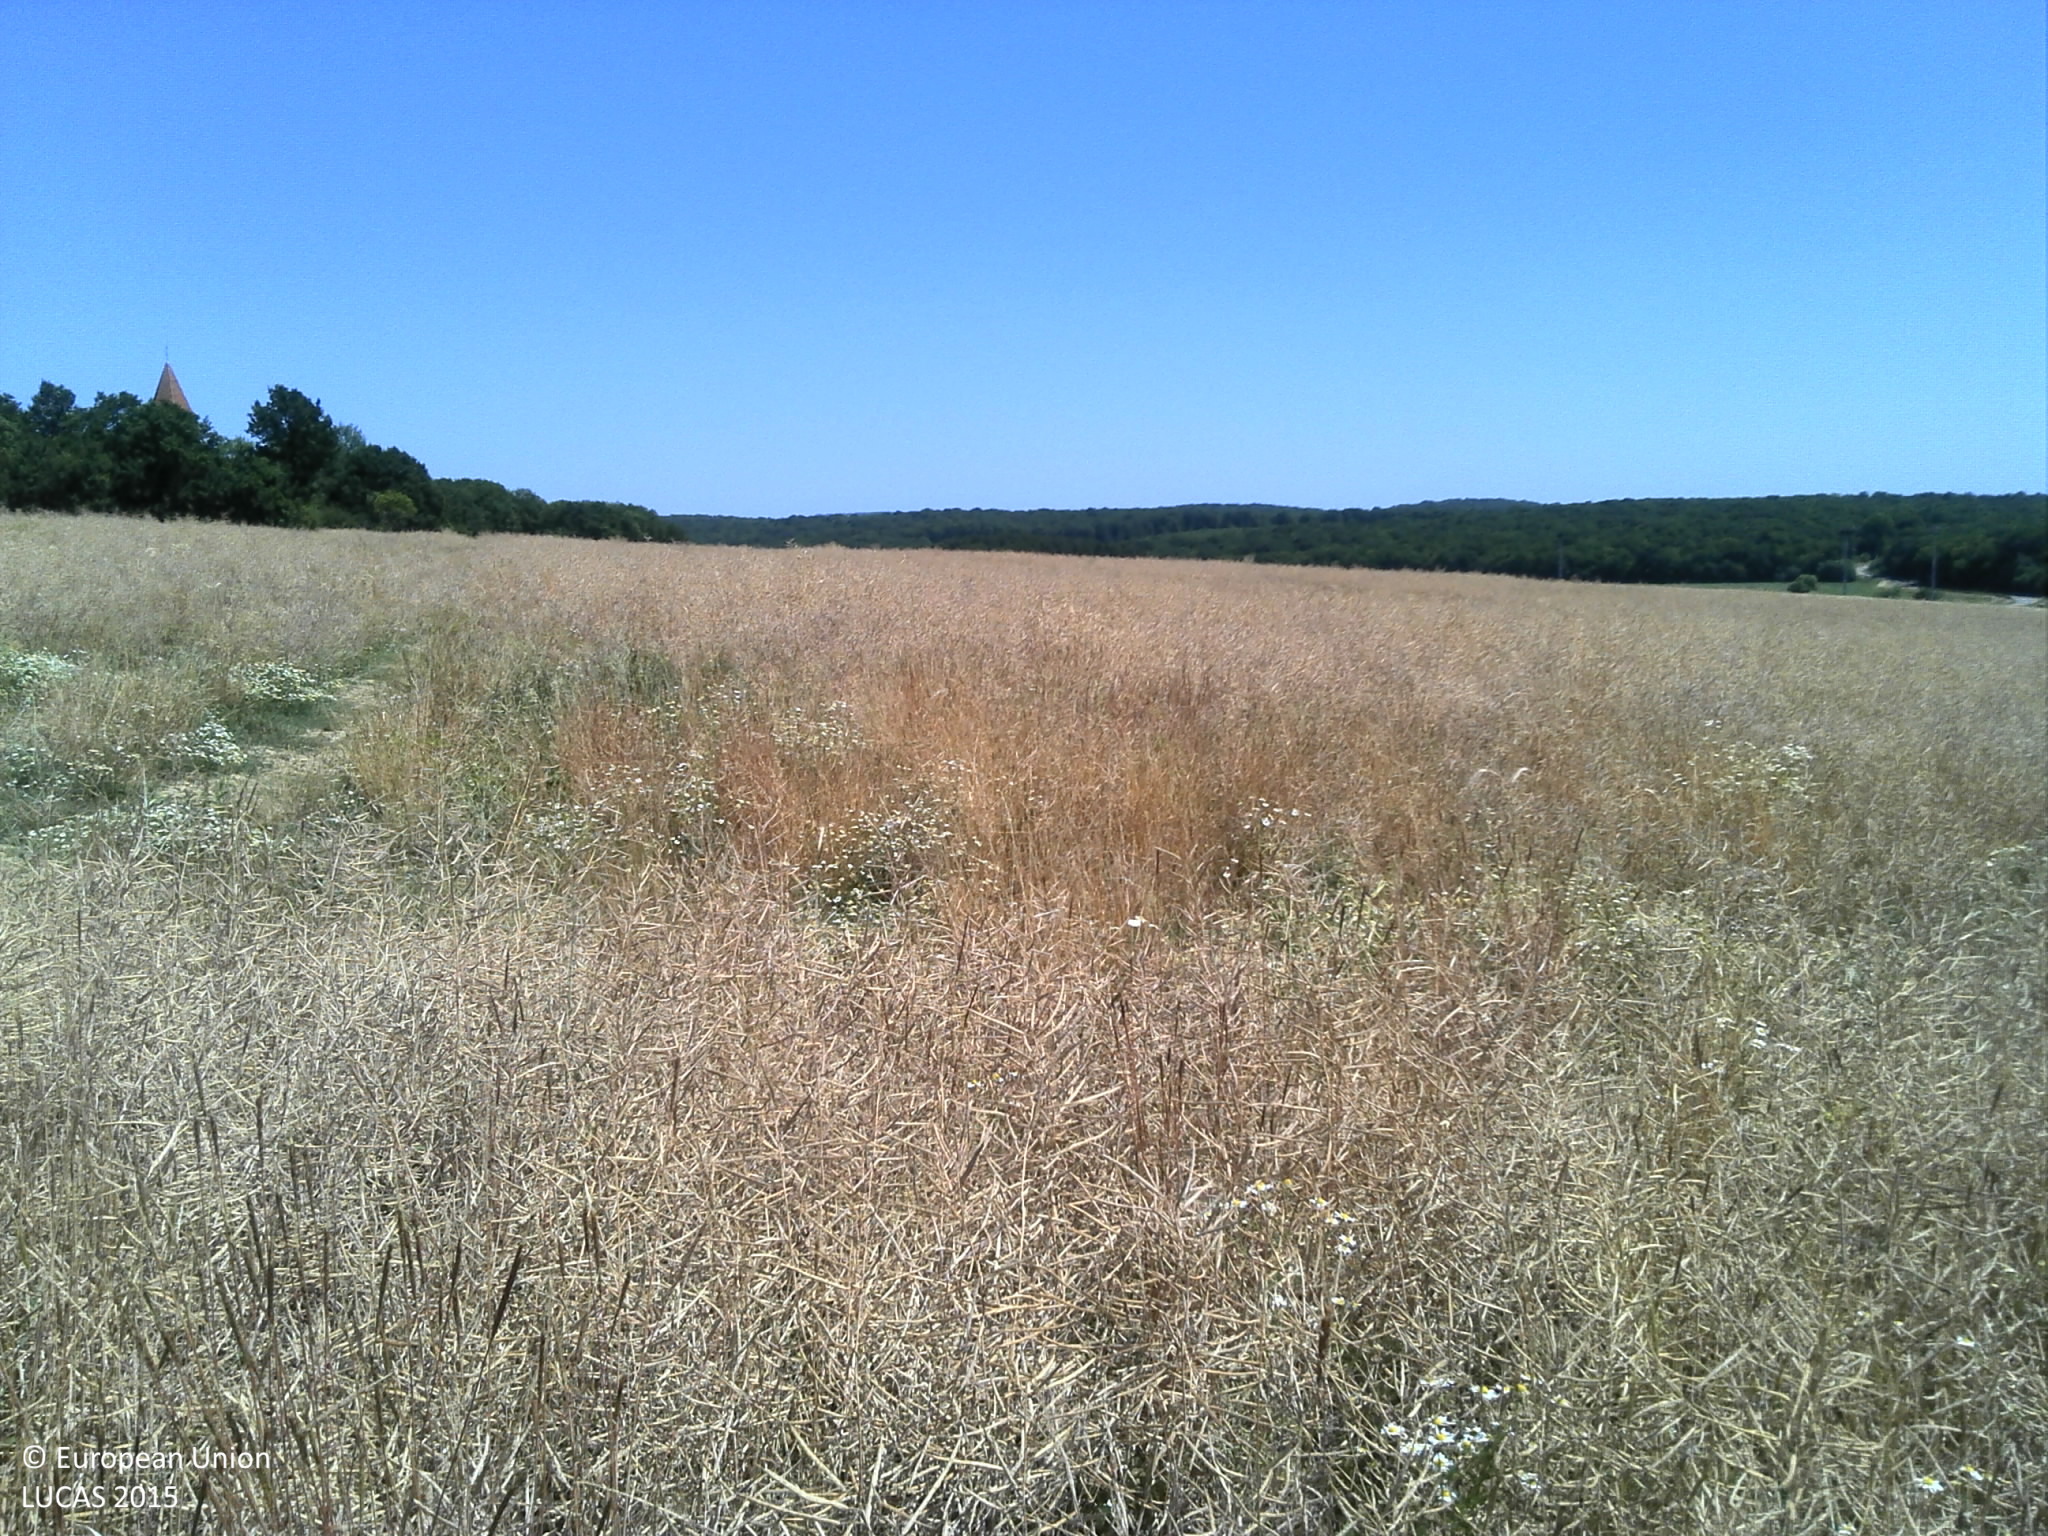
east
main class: Cropland
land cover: Rape and turnip rape
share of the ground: > 75 %
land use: Agriculture (excluding fallow land and kitchen gardens)
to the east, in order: Rape and turnip rape; Common wheat; Rape and turnip rape
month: July
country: FR
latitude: 49.4370
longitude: 6.2073
